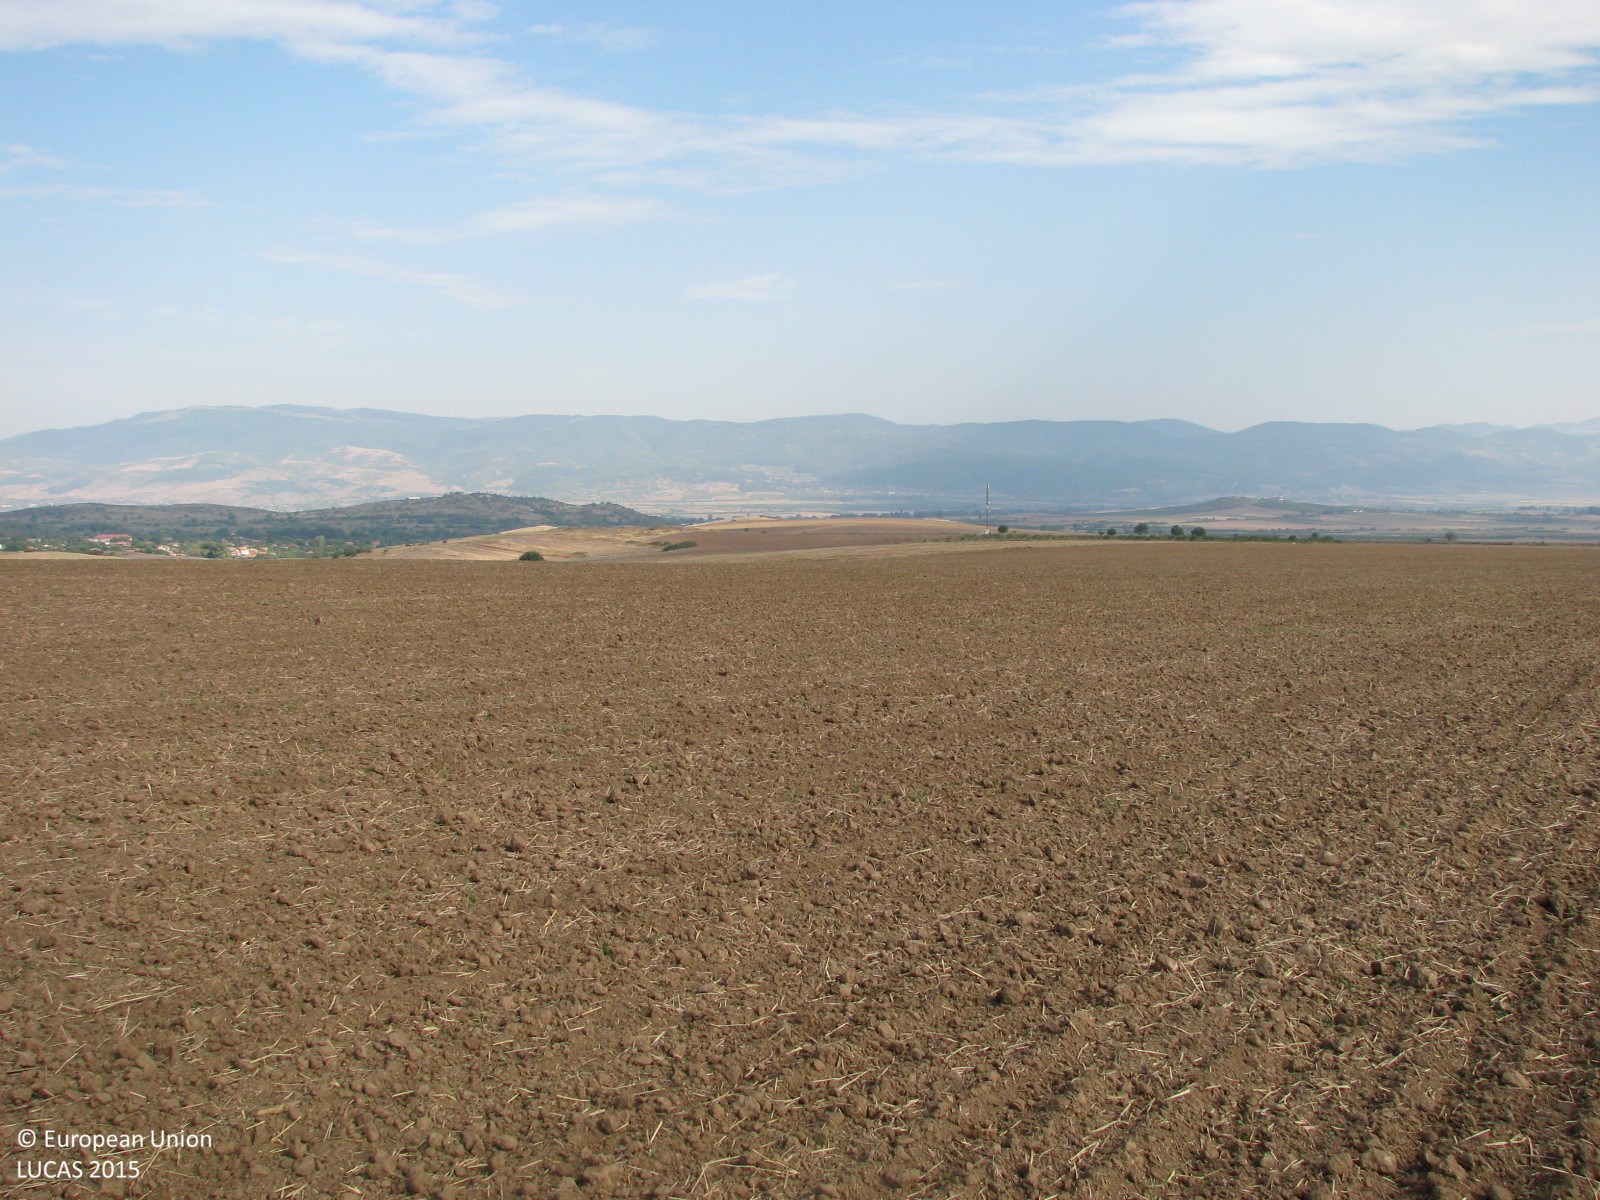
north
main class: Cropland
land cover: Common wheat
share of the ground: < 10 %
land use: Agriculture (excluding fallow land and kitchen gardens)
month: September
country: BG
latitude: 42.5707
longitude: 26.2034
